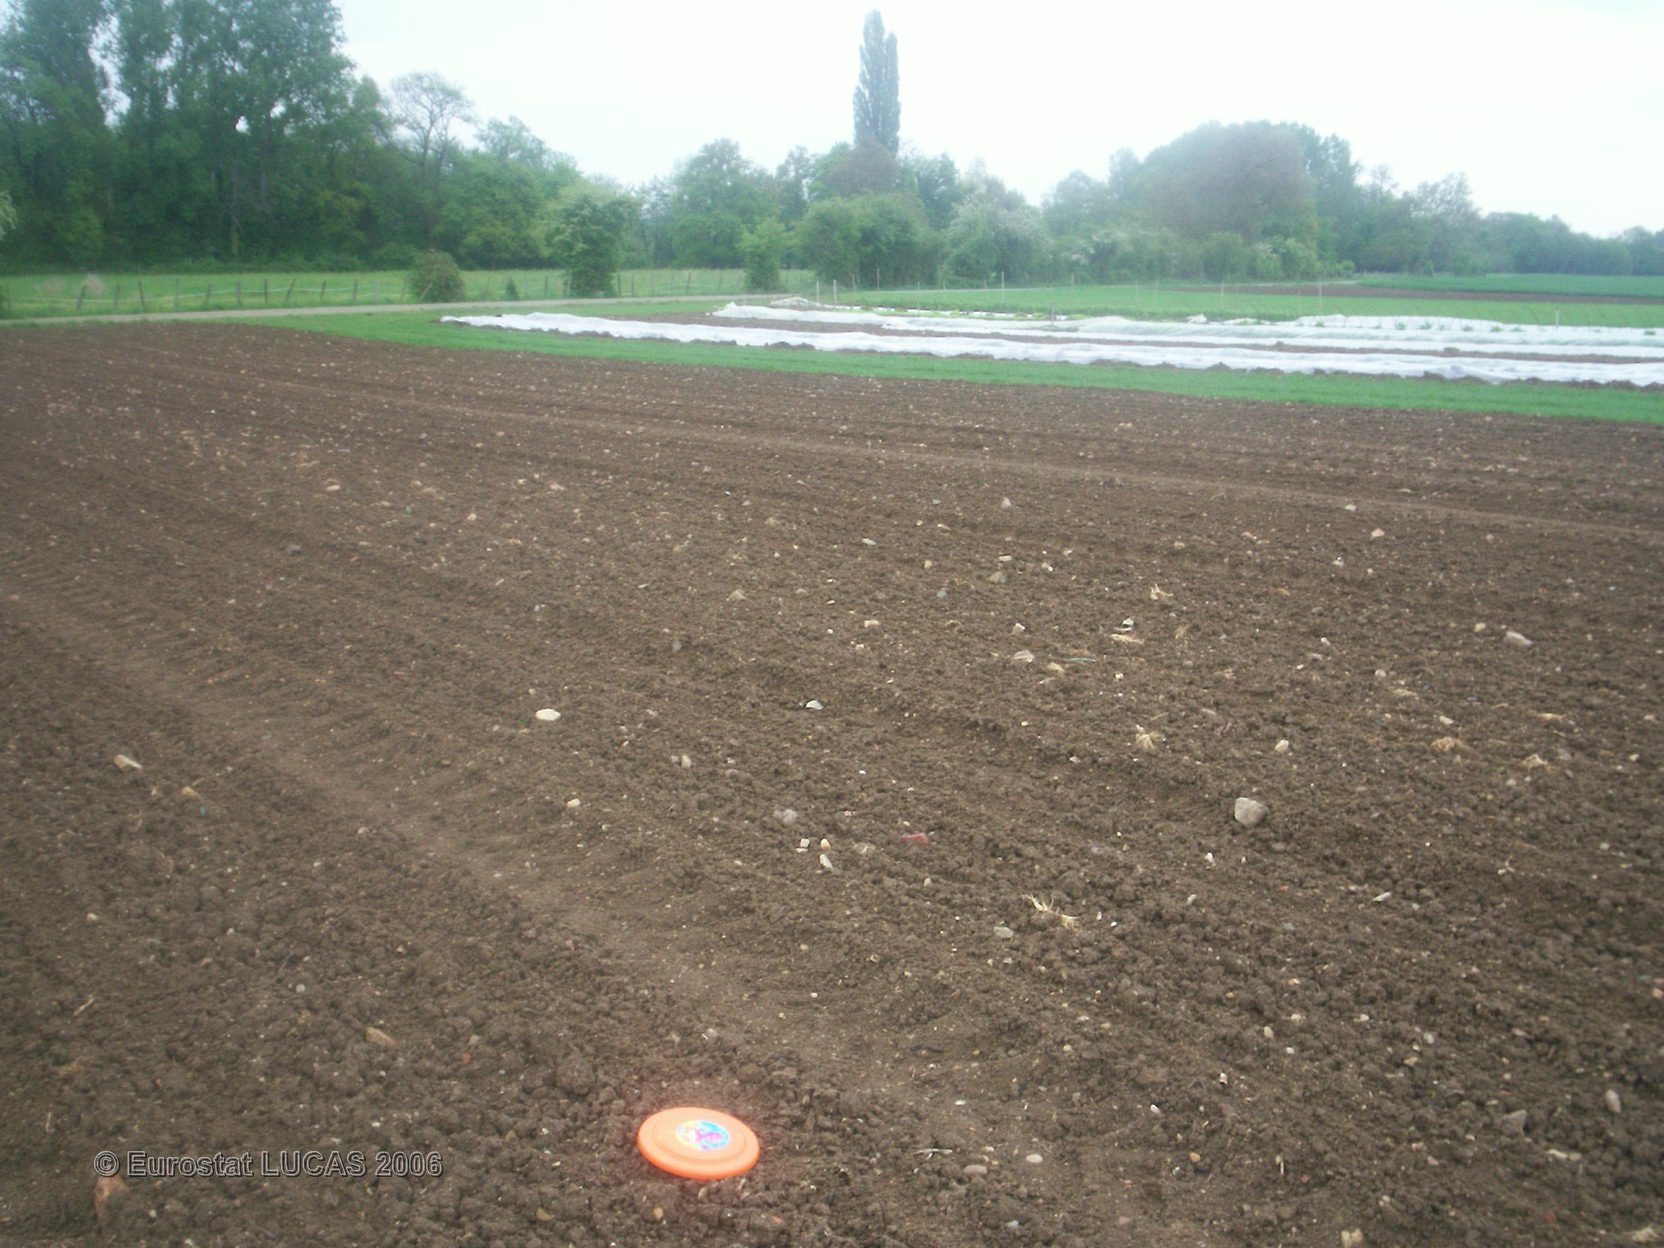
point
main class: Cropland
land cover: Maize
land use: Agriculture (excluding fallow land and kitchen gardens)
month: May
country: FR
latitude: 45.9866
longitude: 3.1444
